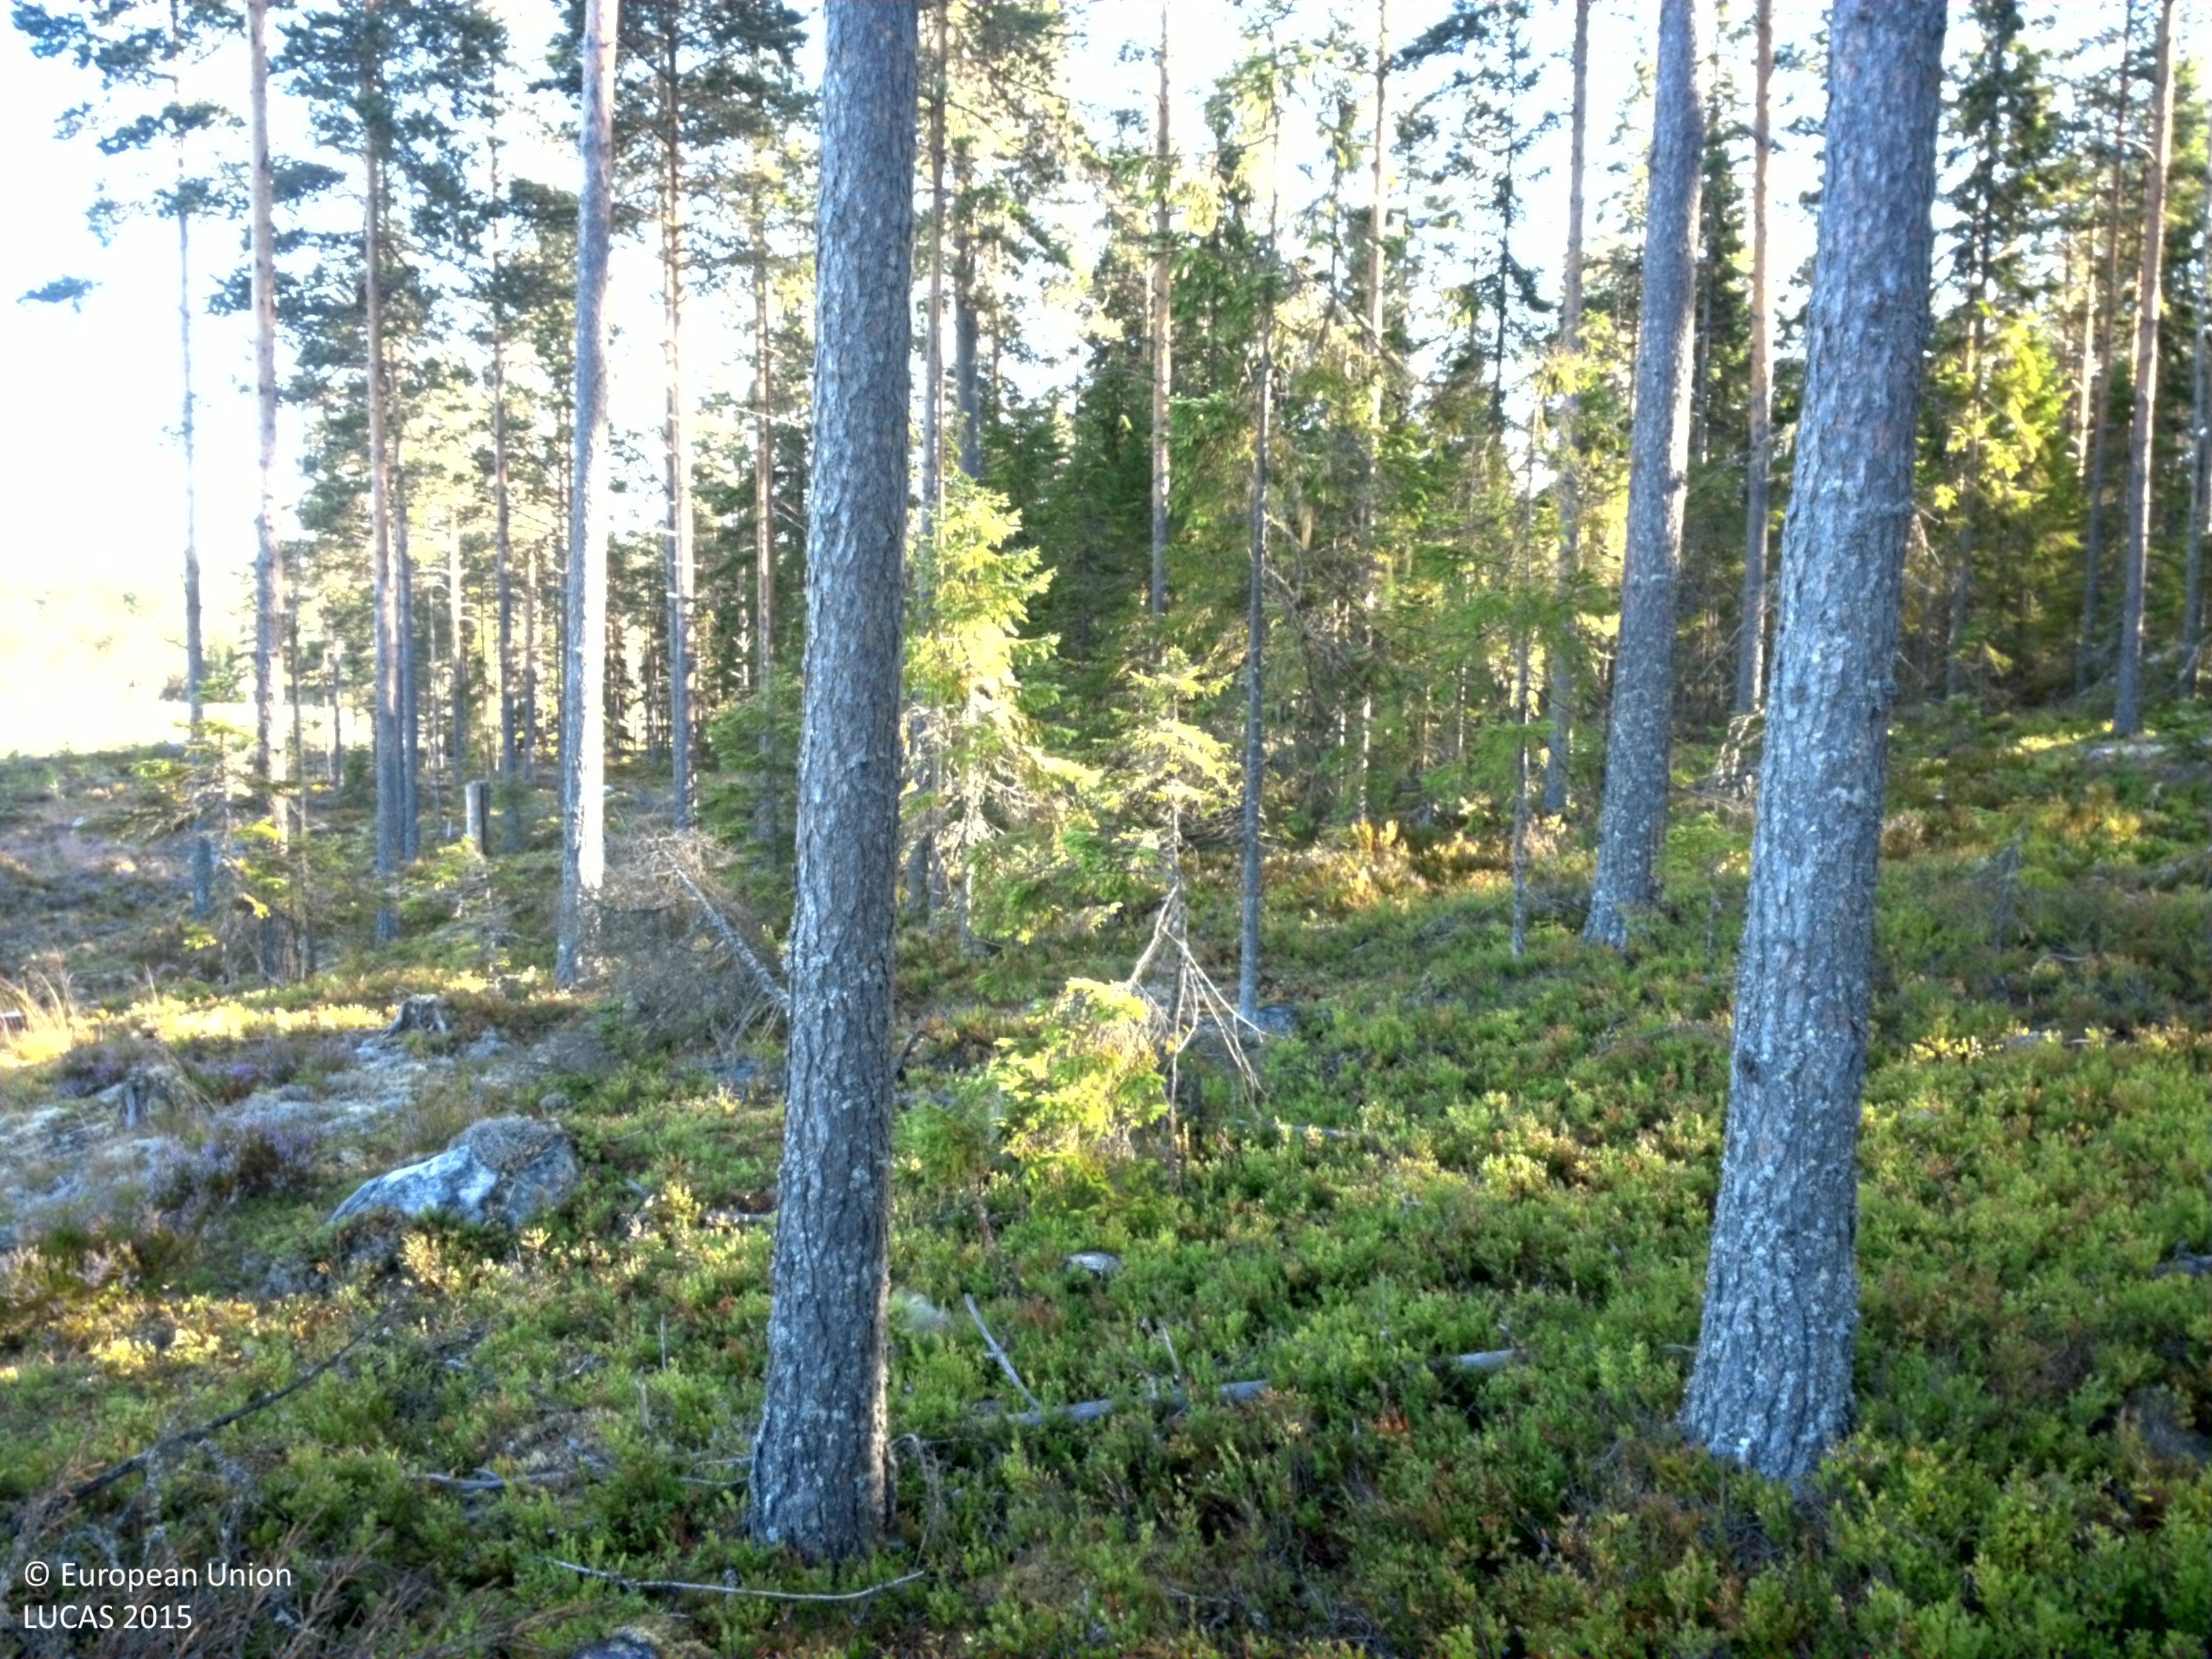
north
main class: Woodland
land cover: Other coniferous woodland
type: boreal forest
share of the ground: 50 - 75 %
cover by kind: coniferous forest trees 70 %, shrubs 30 %
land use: Forestry
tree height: > 5 m
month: August
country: SE
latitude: 60.0109
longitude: 14.1690
